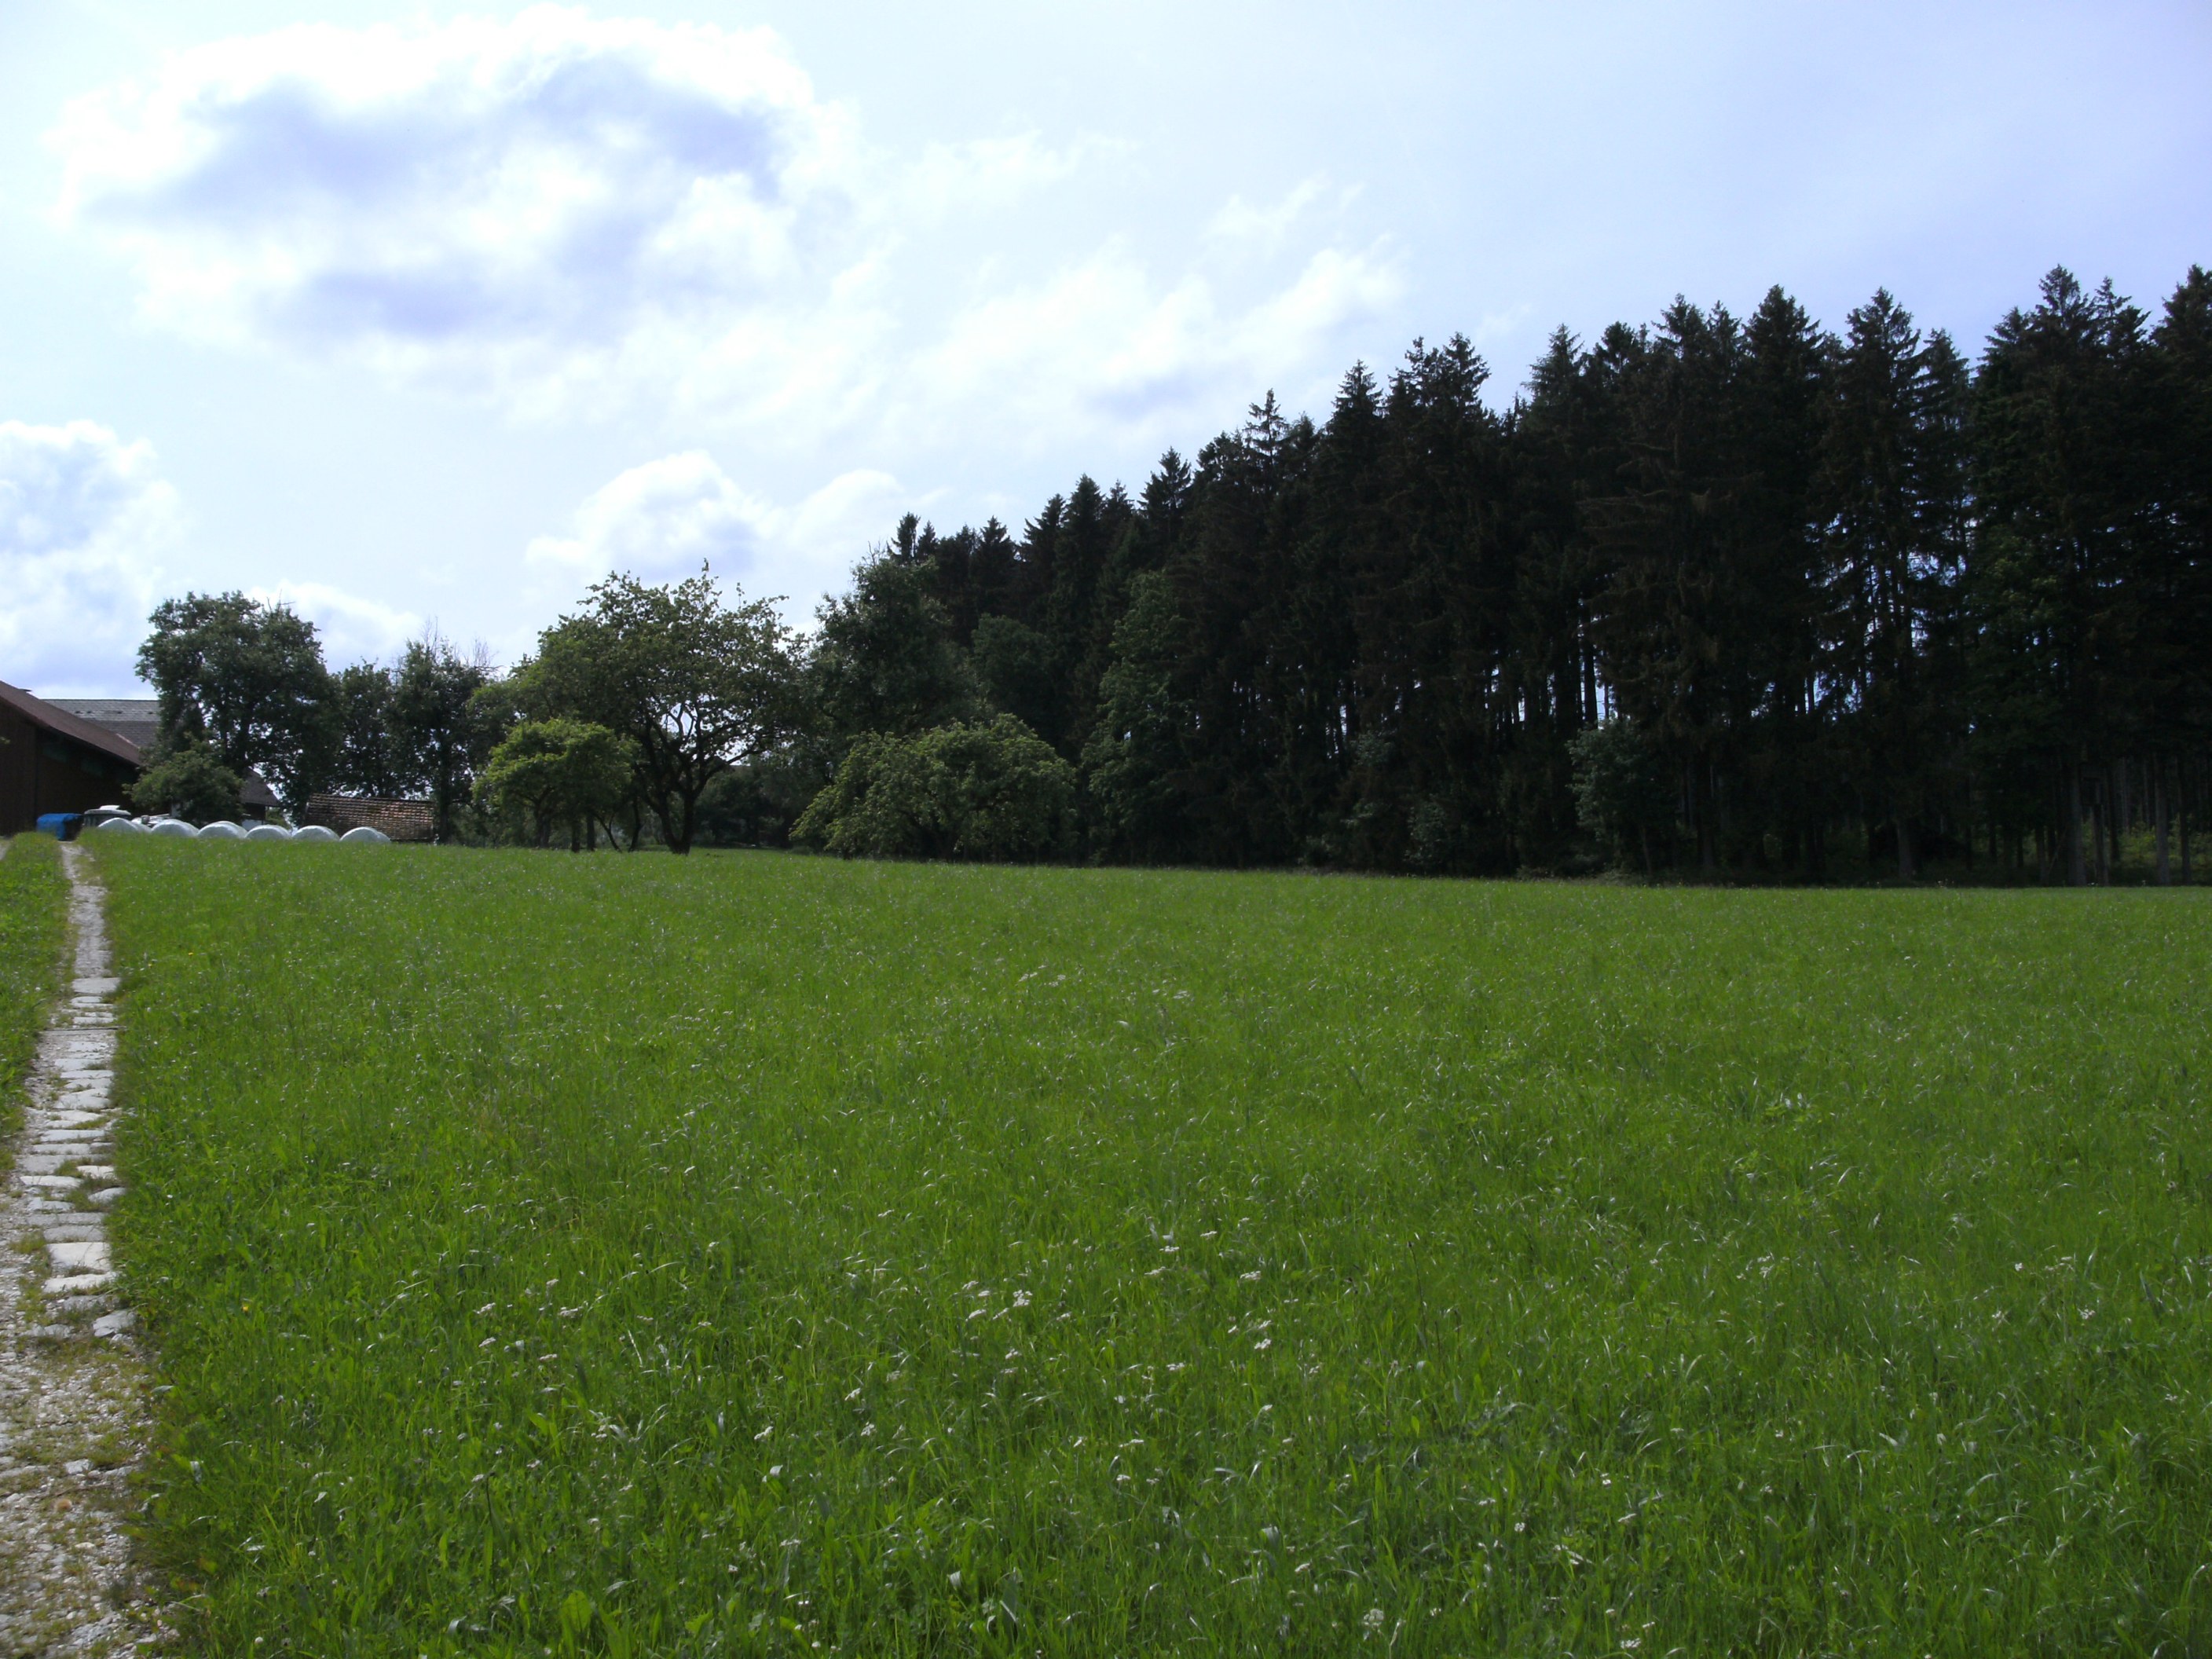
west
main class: Grassland
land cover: Grassland without tree/shrub cover
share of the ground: > 75 %
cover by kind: herbaceous plants 100 %
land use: Agriculture (excluding fallow land and kitchen gardens)
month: June
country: AT
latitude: 48.0967
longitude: 13.4769
